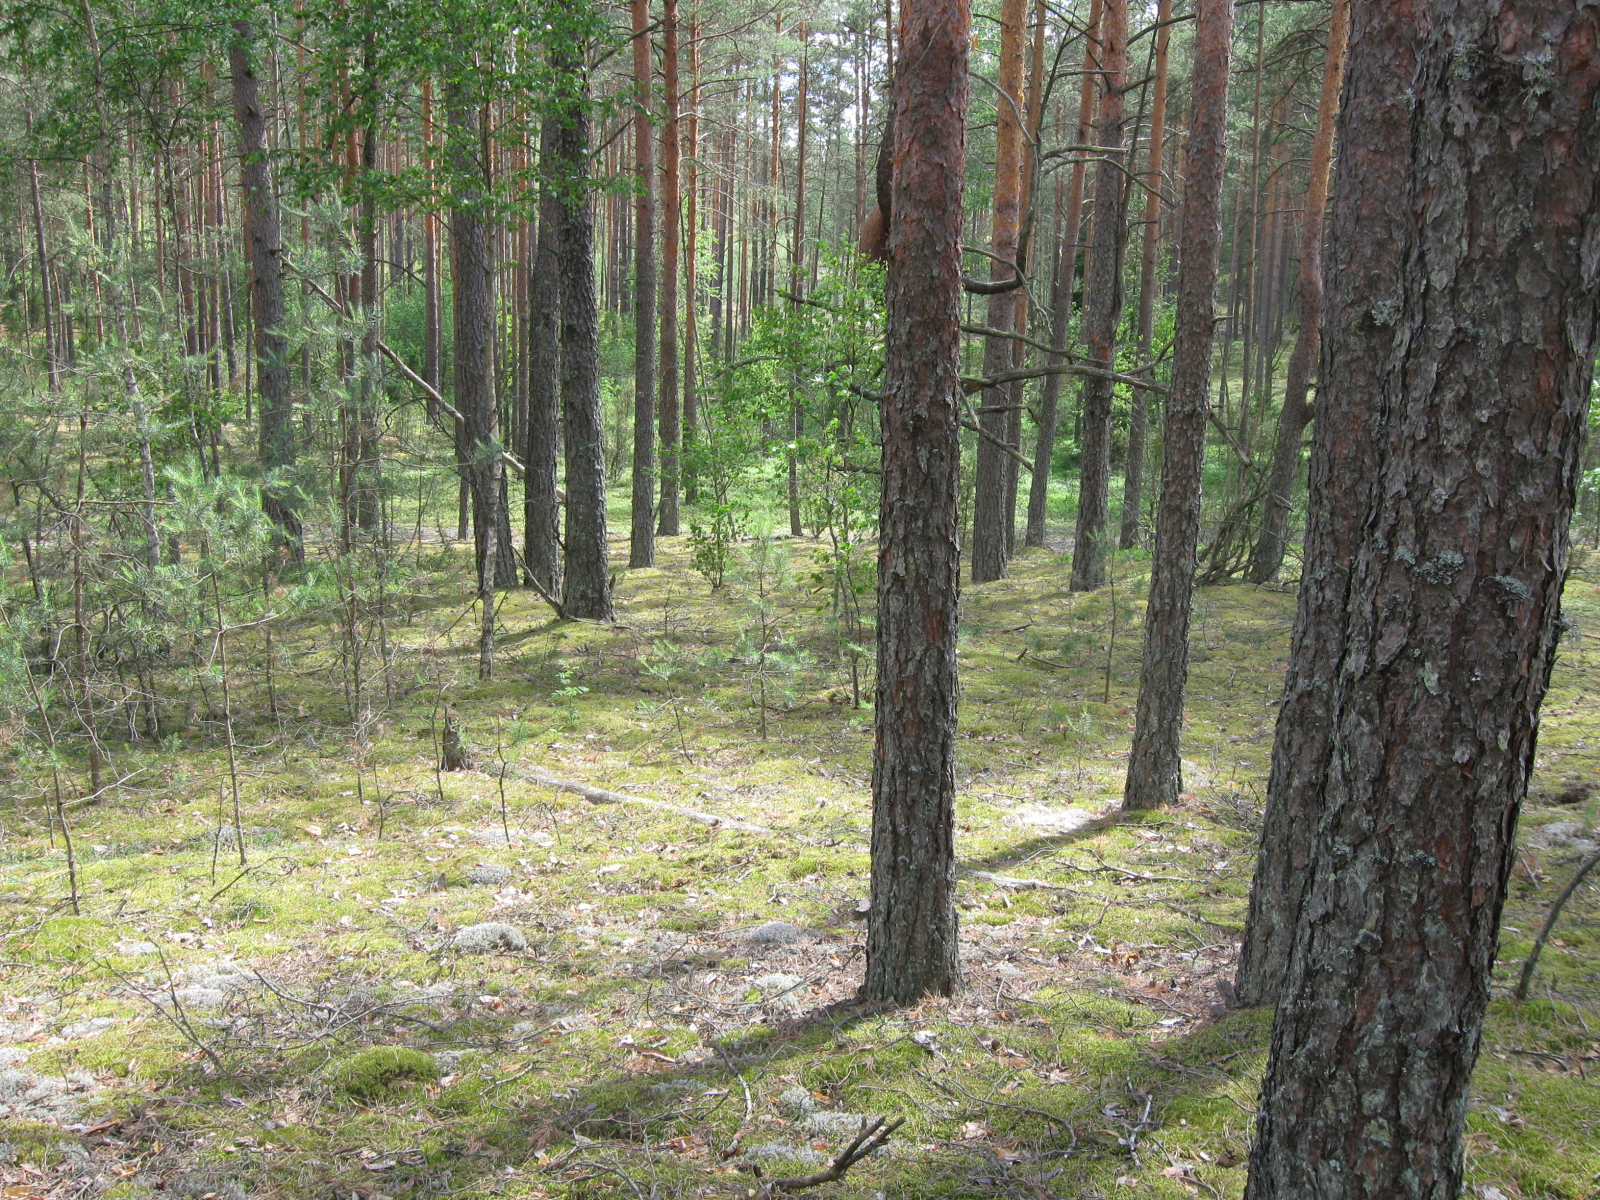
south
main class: Woodland
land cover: Pine dominated coniferous woodland
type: hemiboreal forest and nemoral coniferous forest and mixed broadleaved-coniferous forest
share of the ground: > 75 %
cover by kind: coniferous forest trees 95 %, lichens and mosses 5 %
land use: Forestry
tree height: > 5 m
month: June
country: LT
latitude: 54.0964
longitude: 24.4925
